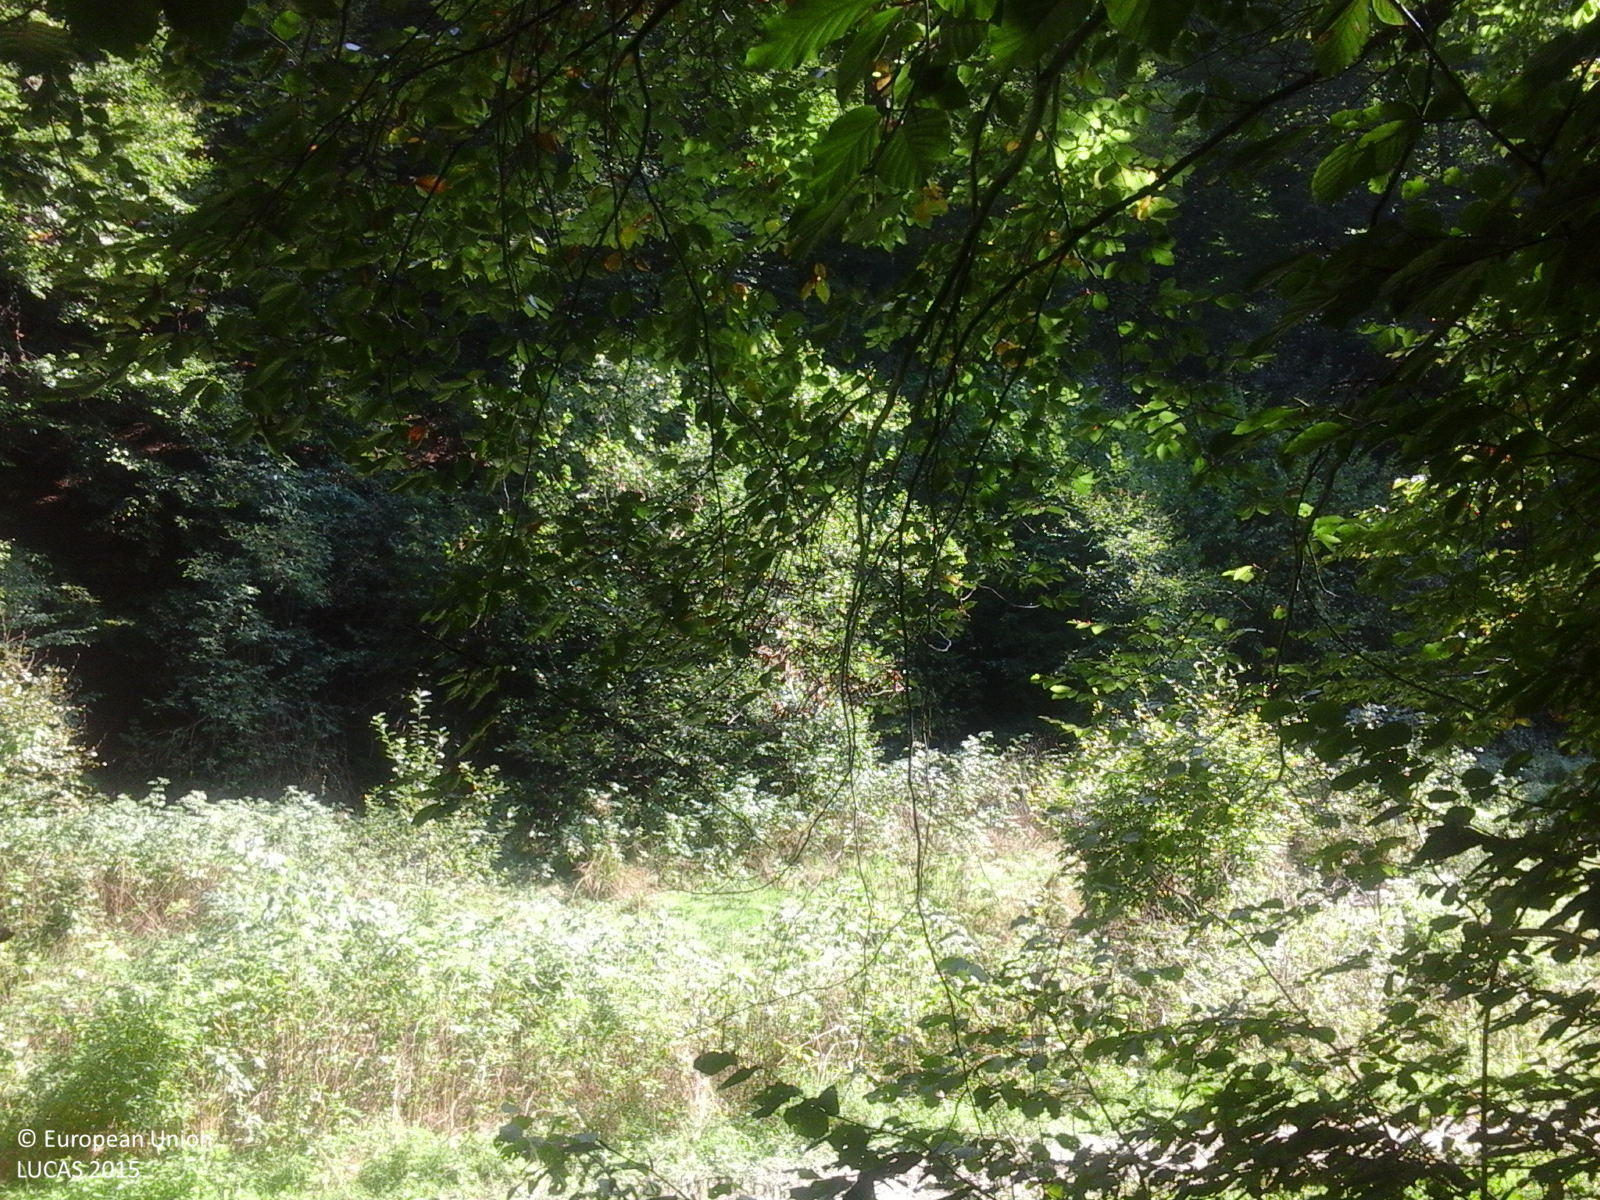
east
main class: Woodland
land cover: Broadleaved woodland
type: beech forest
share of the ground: > 75 %
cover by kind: broadleaved forest trees 100 %
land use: Forestry
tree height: > 5 m
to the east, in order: Broadleaved woodland; Tracks; Spontaneously vegetated surfaces; Rivers and streams; Spontaneously vegetated surfaces; Broadleaved woodland; Tracks; Broadleaved woodland; Grassland with sparse tree/shrub cover; Broadleaved woodland
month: September
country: RO
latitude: 45.7800
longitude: 22.6407
